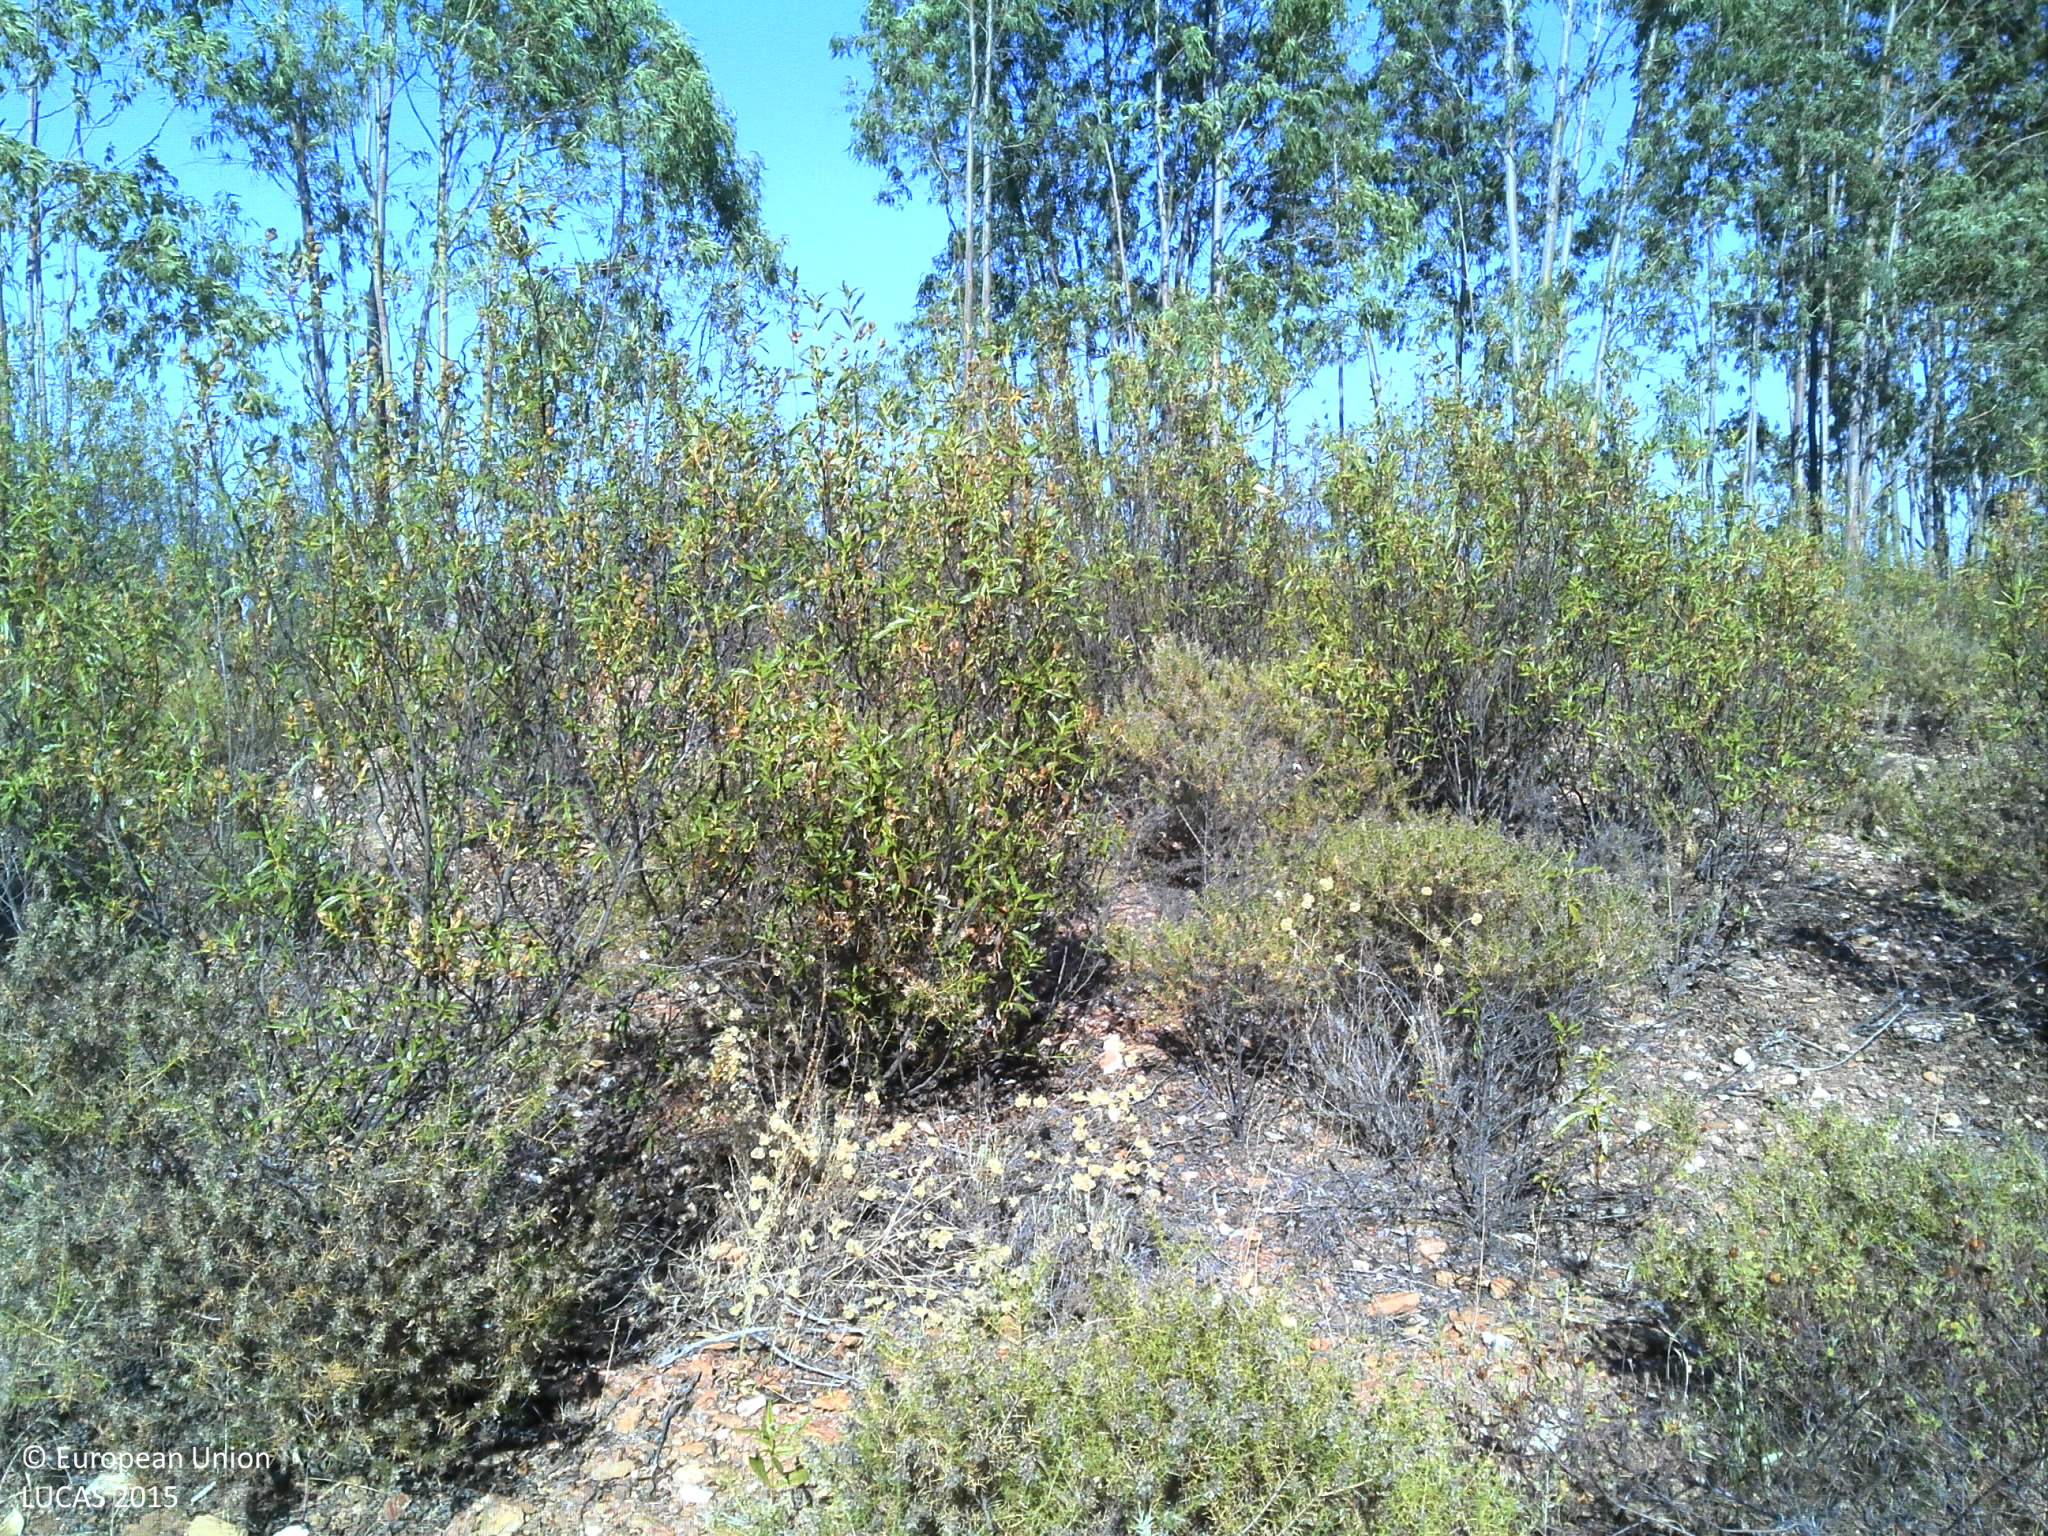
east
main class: Shrubland
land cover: Shrubland with sparse tree cover
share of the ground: > 75 %
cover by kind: shrubs 90 %, broadleaved forest trees 5 %, unconsolidated bare surface 5 %
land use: Abandoned areas
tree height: < 5 m
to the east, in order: Shrubland with sparse tree cover; Tracks; Broadleaved woodland; Other structural elements; Shrubland with sparse tree cover; Rivers and streams; Shrubland with sparse tree cover; Broadleaved woodland; Fences; Broadleaved woodland
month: June
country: PT
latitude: 37.9068
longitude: -7.2892
